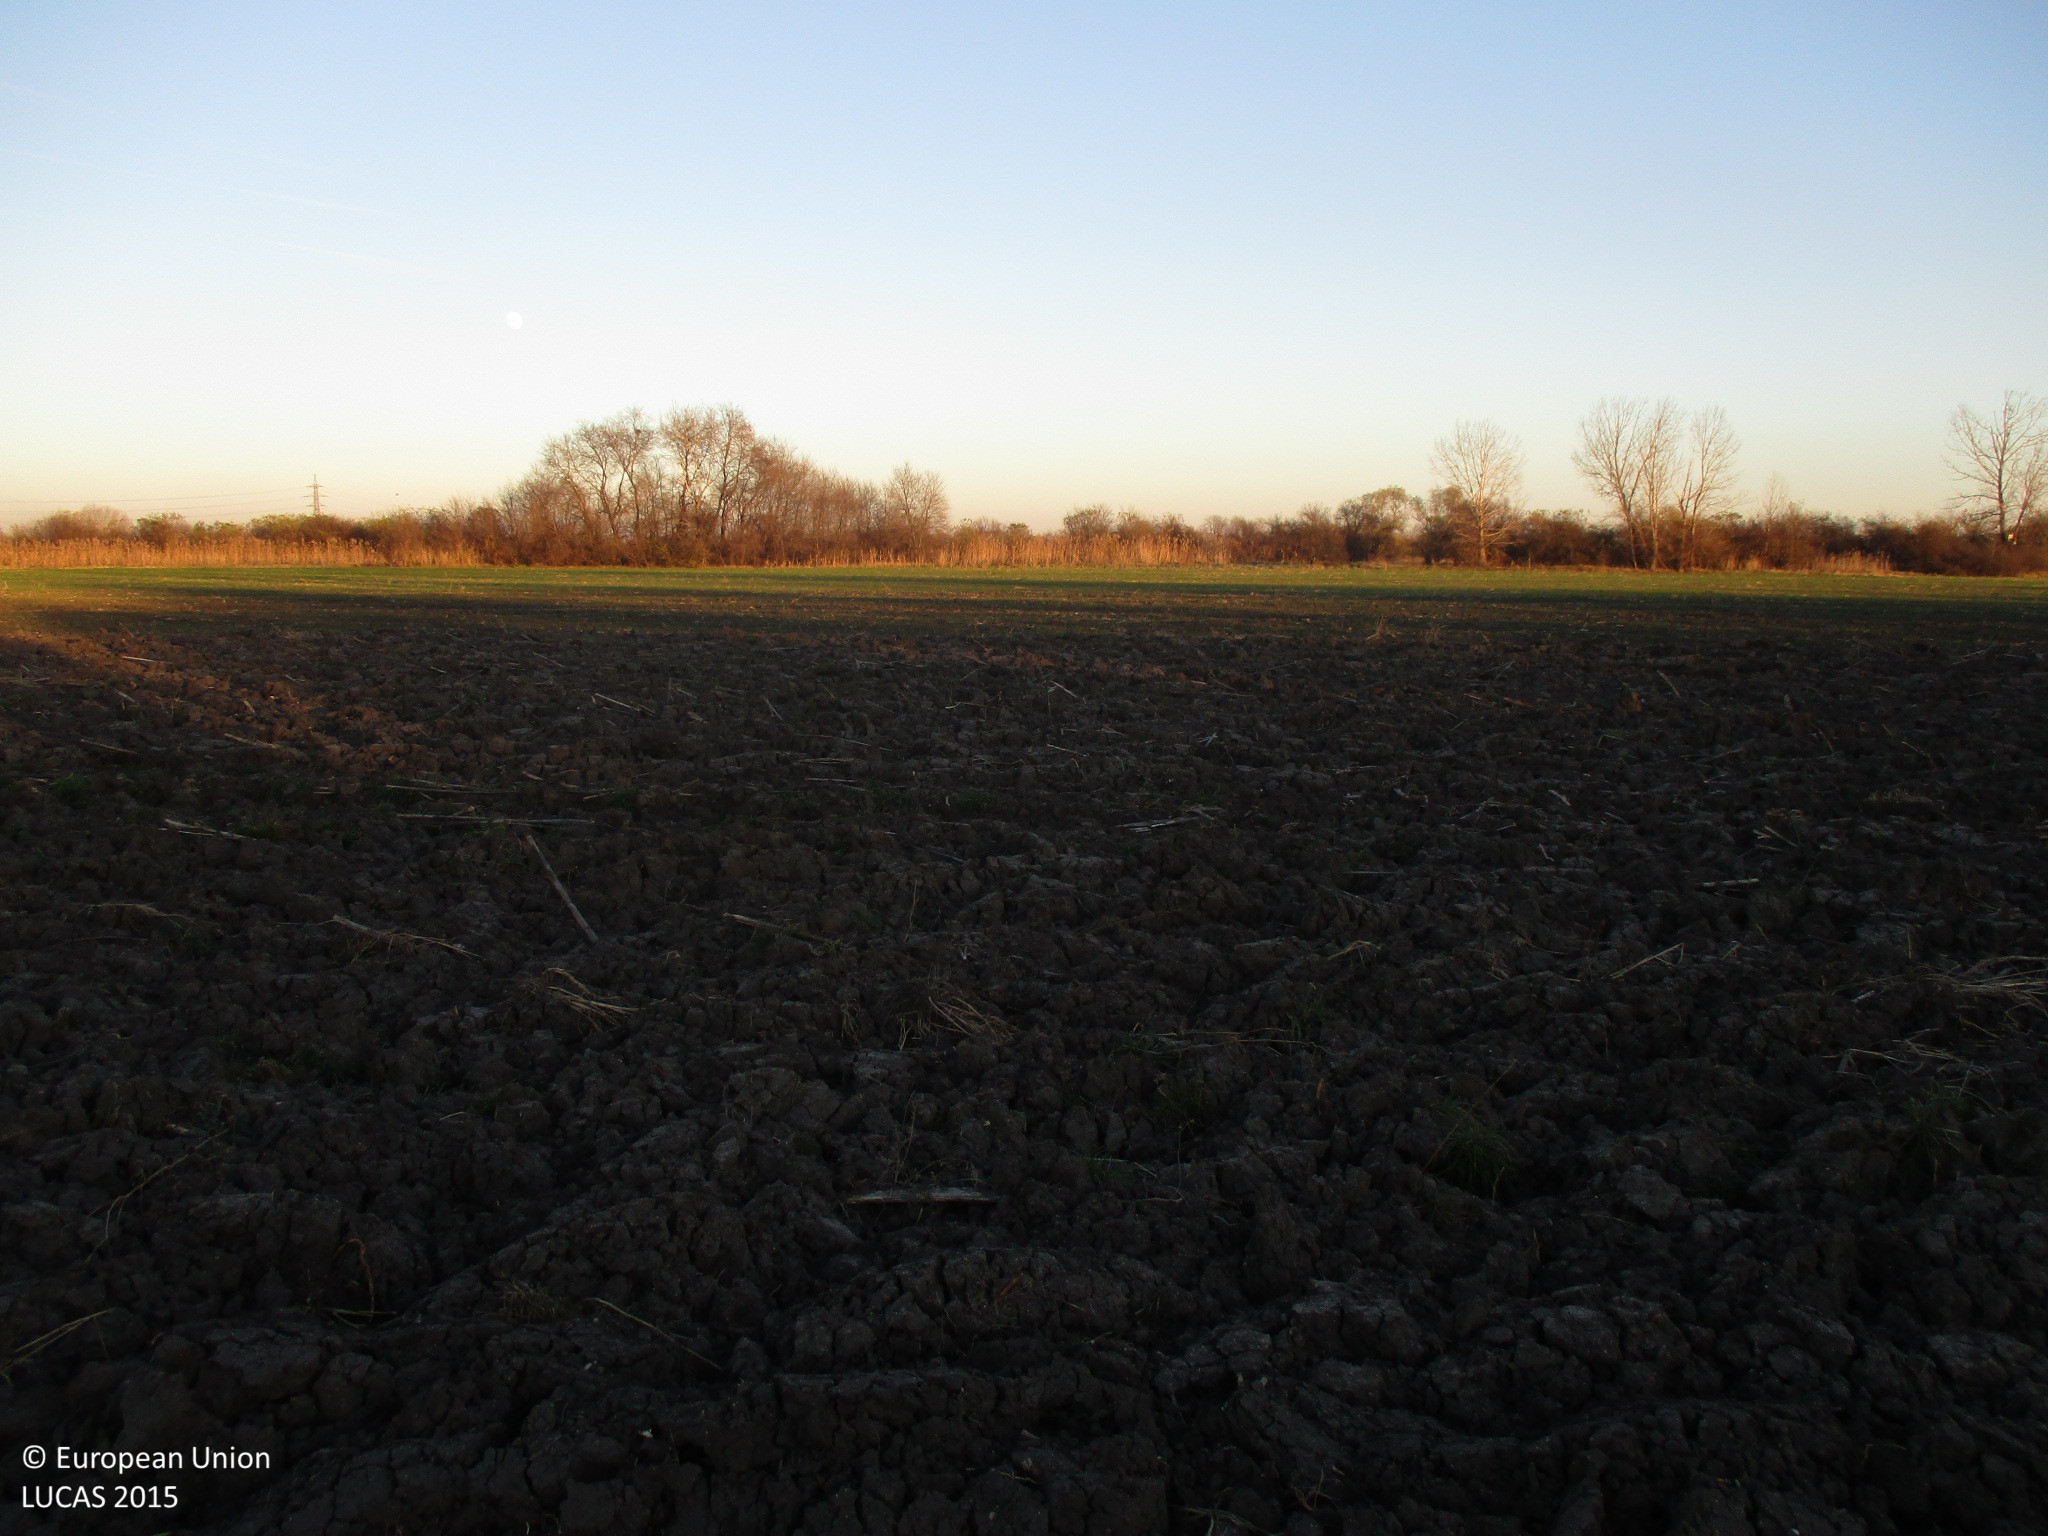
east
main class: Cropland
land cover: Sunflower
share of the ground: < 10 %
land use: Agriculture (excluding fallow land and kitchen gardens)
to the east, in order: Sunflower; Other cereals; Grass margins; Broadleaved woodland; Ditches and canals; Grassland with sparse tree/shrub cover; Spontaneously vegetated surfaces; Lucerne
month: December
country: BG
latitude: 42.1707
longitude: 24.7598
